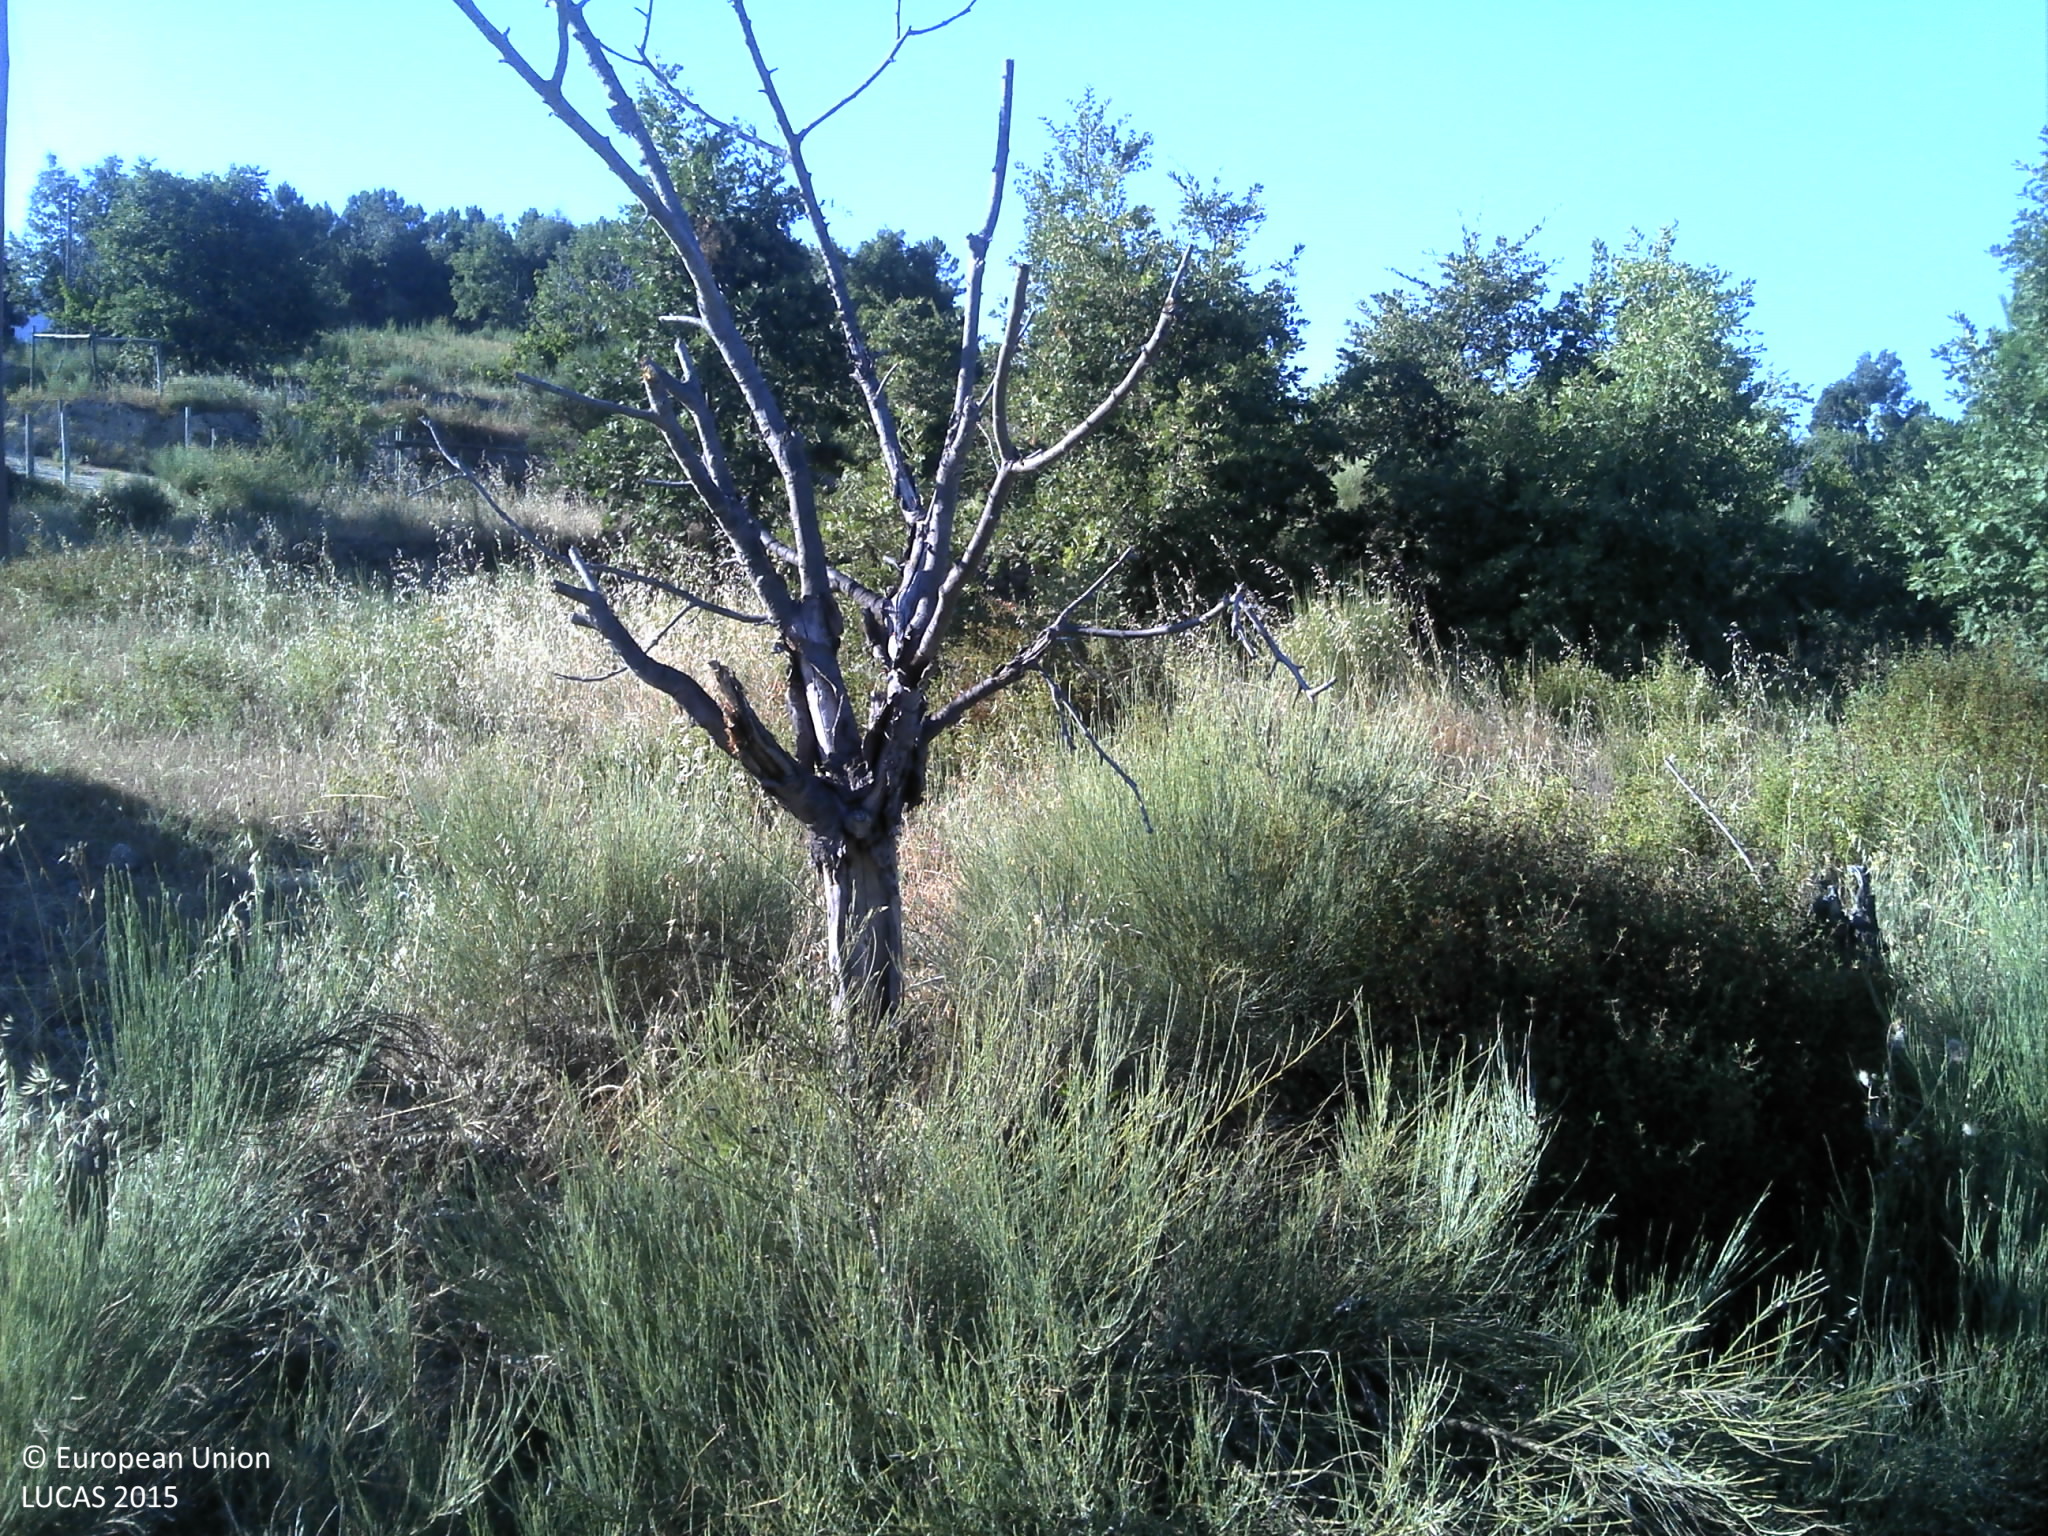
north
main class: Shrubland
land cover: Shrubland with sparse tree cover
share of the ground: 50 - 75 %
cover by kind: shrubs 65 %, unconsolidated bare surface 25 %, broadleaved forest trees 5 %, herbaceous plants 5 %
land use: Forestry
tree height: < 5 m
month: June
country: PT
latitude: 40.0749
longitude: -7.4452
